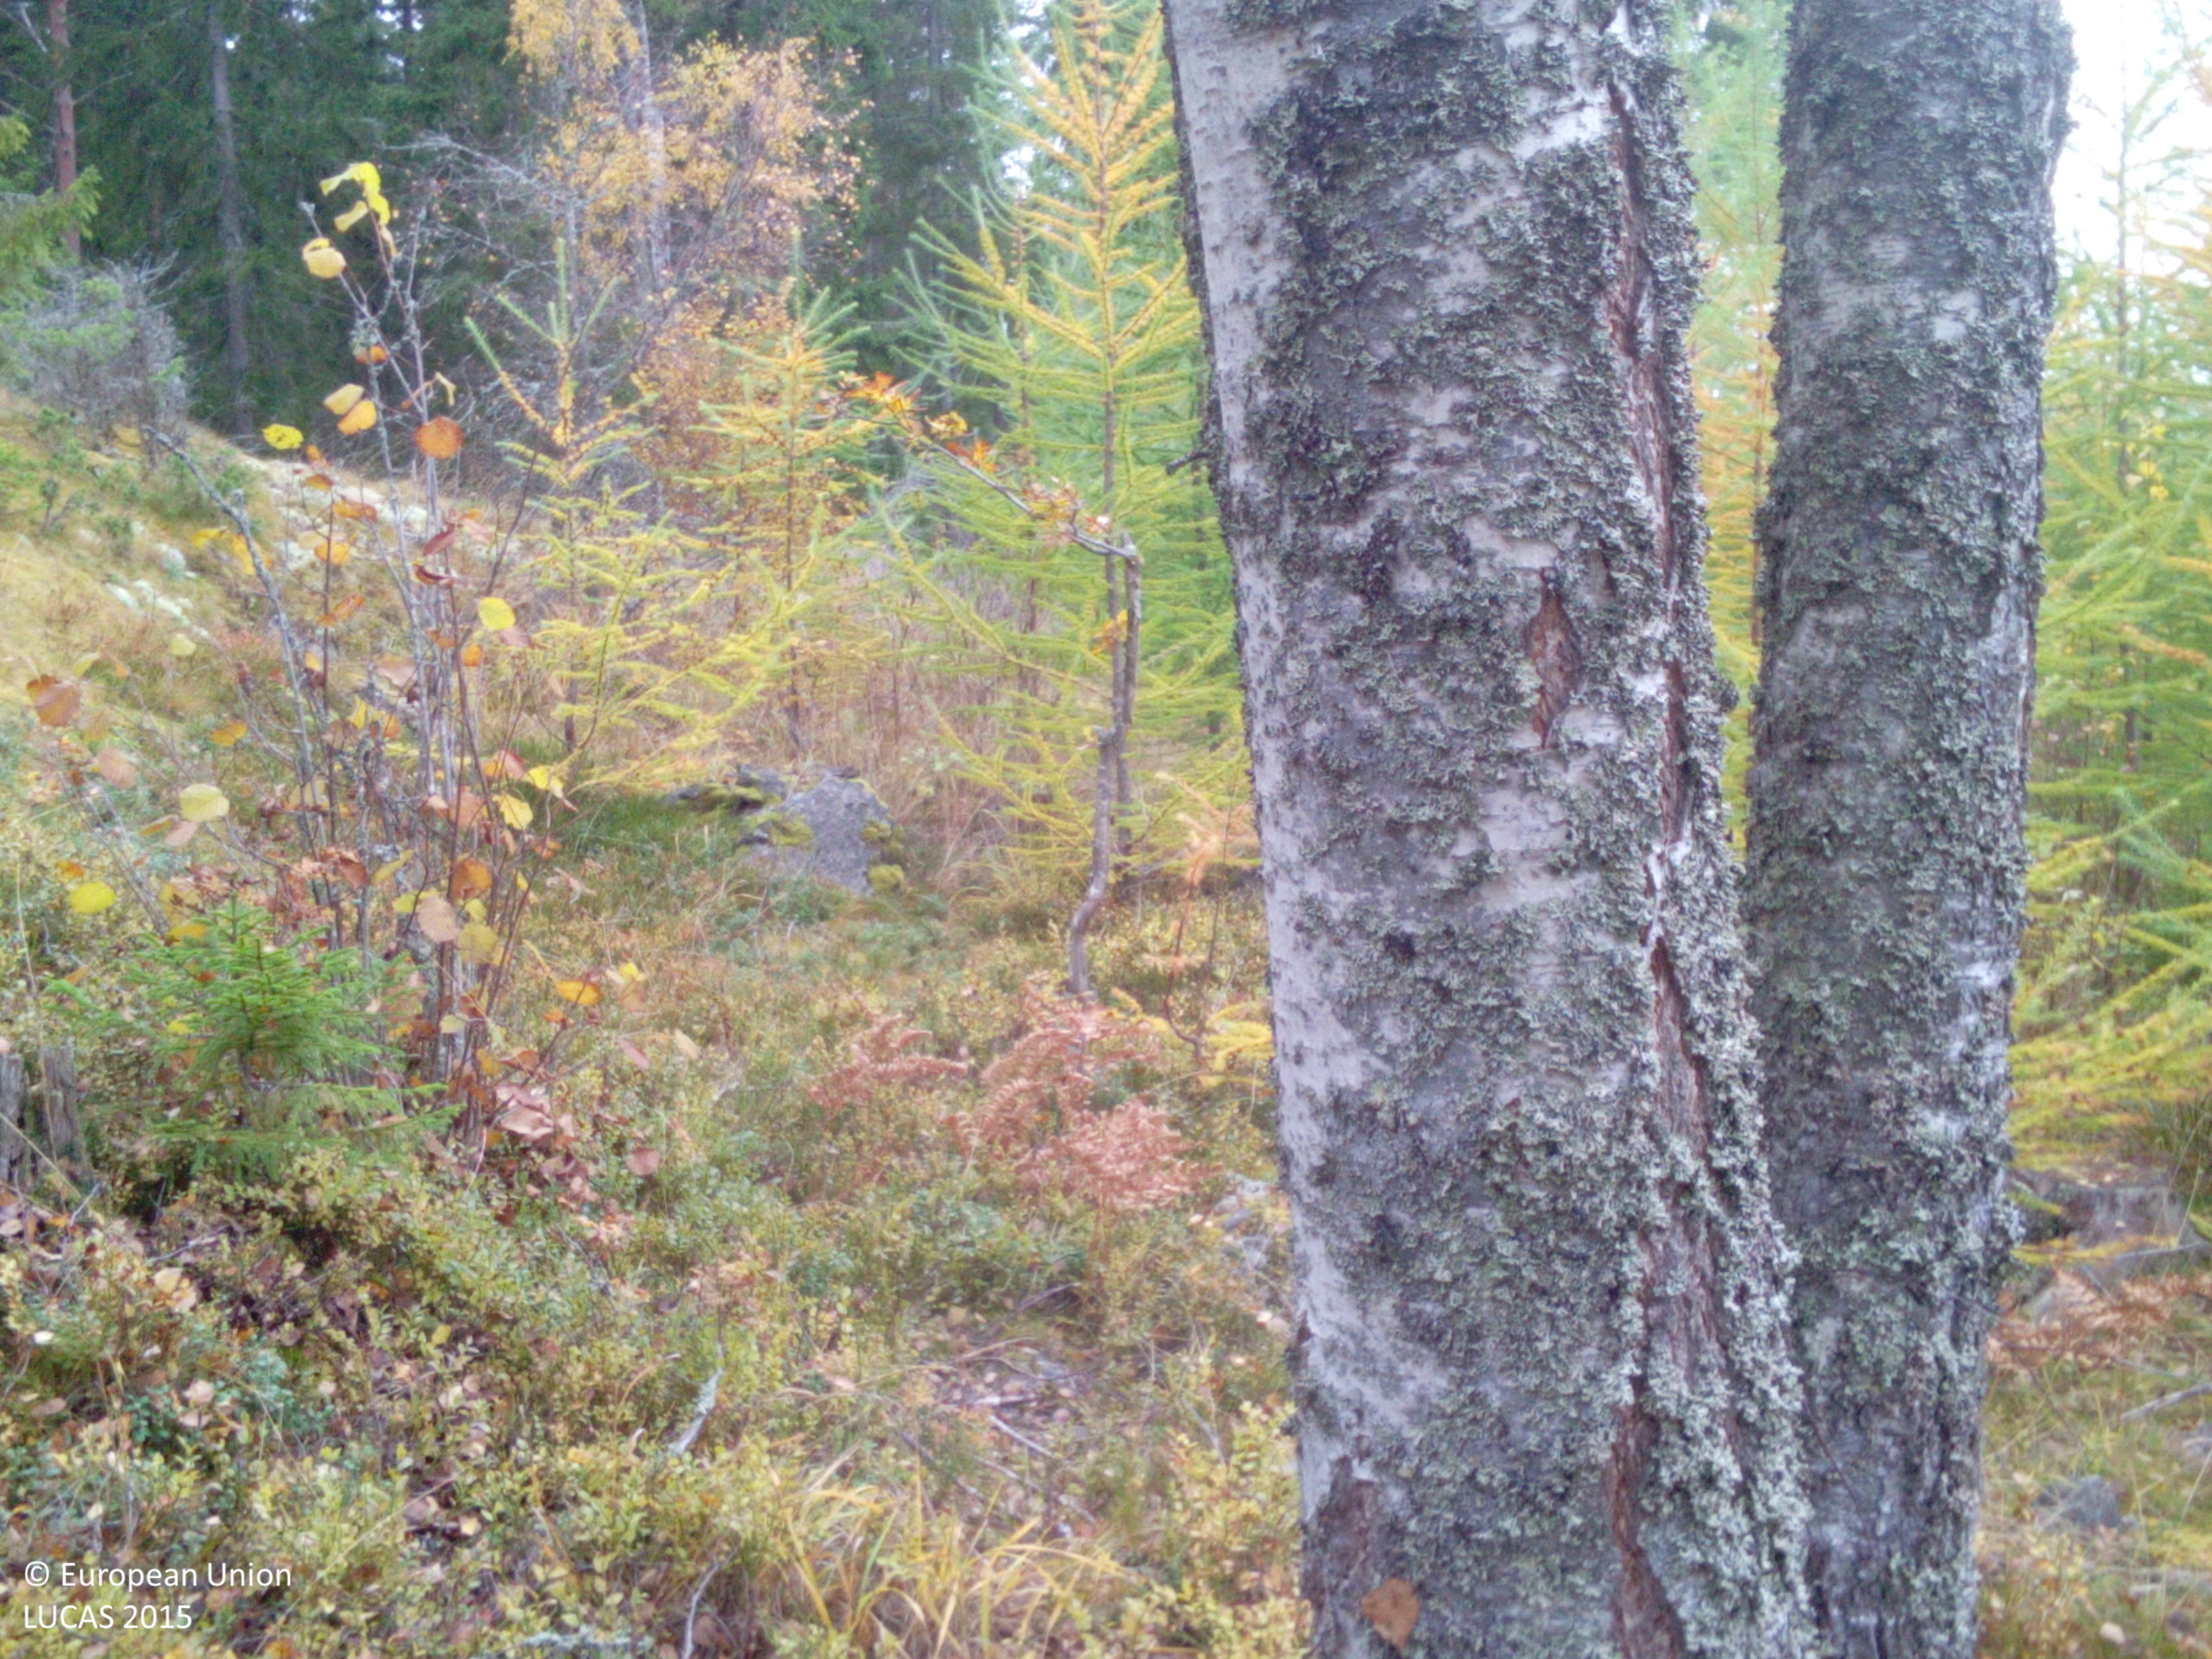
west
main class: Woodland
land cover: Spruce dominated mixed woodland
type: boreal forest
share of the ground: 50 - 75 %
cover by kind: coniferous forest trees 50 %, broadleaved forest trees 25 %, lichens and mosses 15 %, herbaceous plants 10 %
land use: Forestry
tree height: > 5 m
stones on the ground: > 50 %
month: October
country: SE
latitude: 59.1742
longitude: 16.2743
